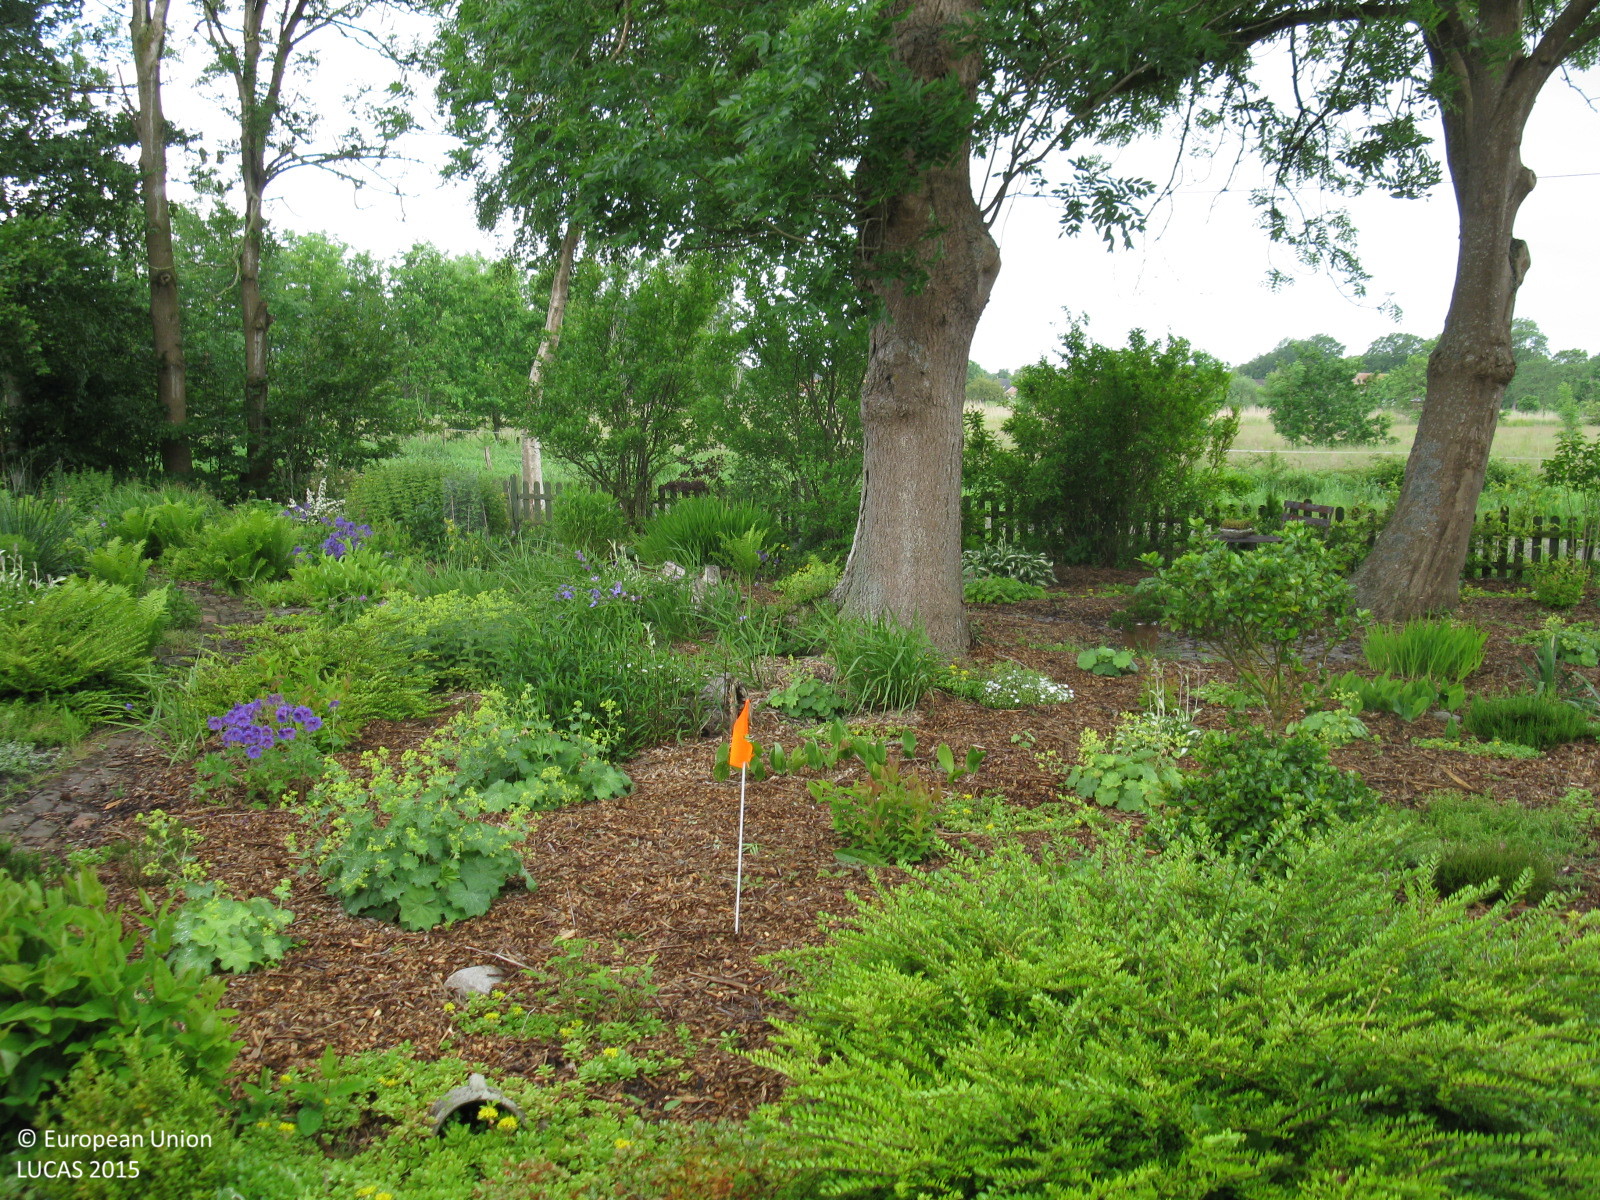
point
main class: Cropland
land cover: Floriculture and ornamental plants
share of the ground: > 75 %
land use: Residential
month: June
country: DE
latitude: 53.5171
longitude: 7.3614
